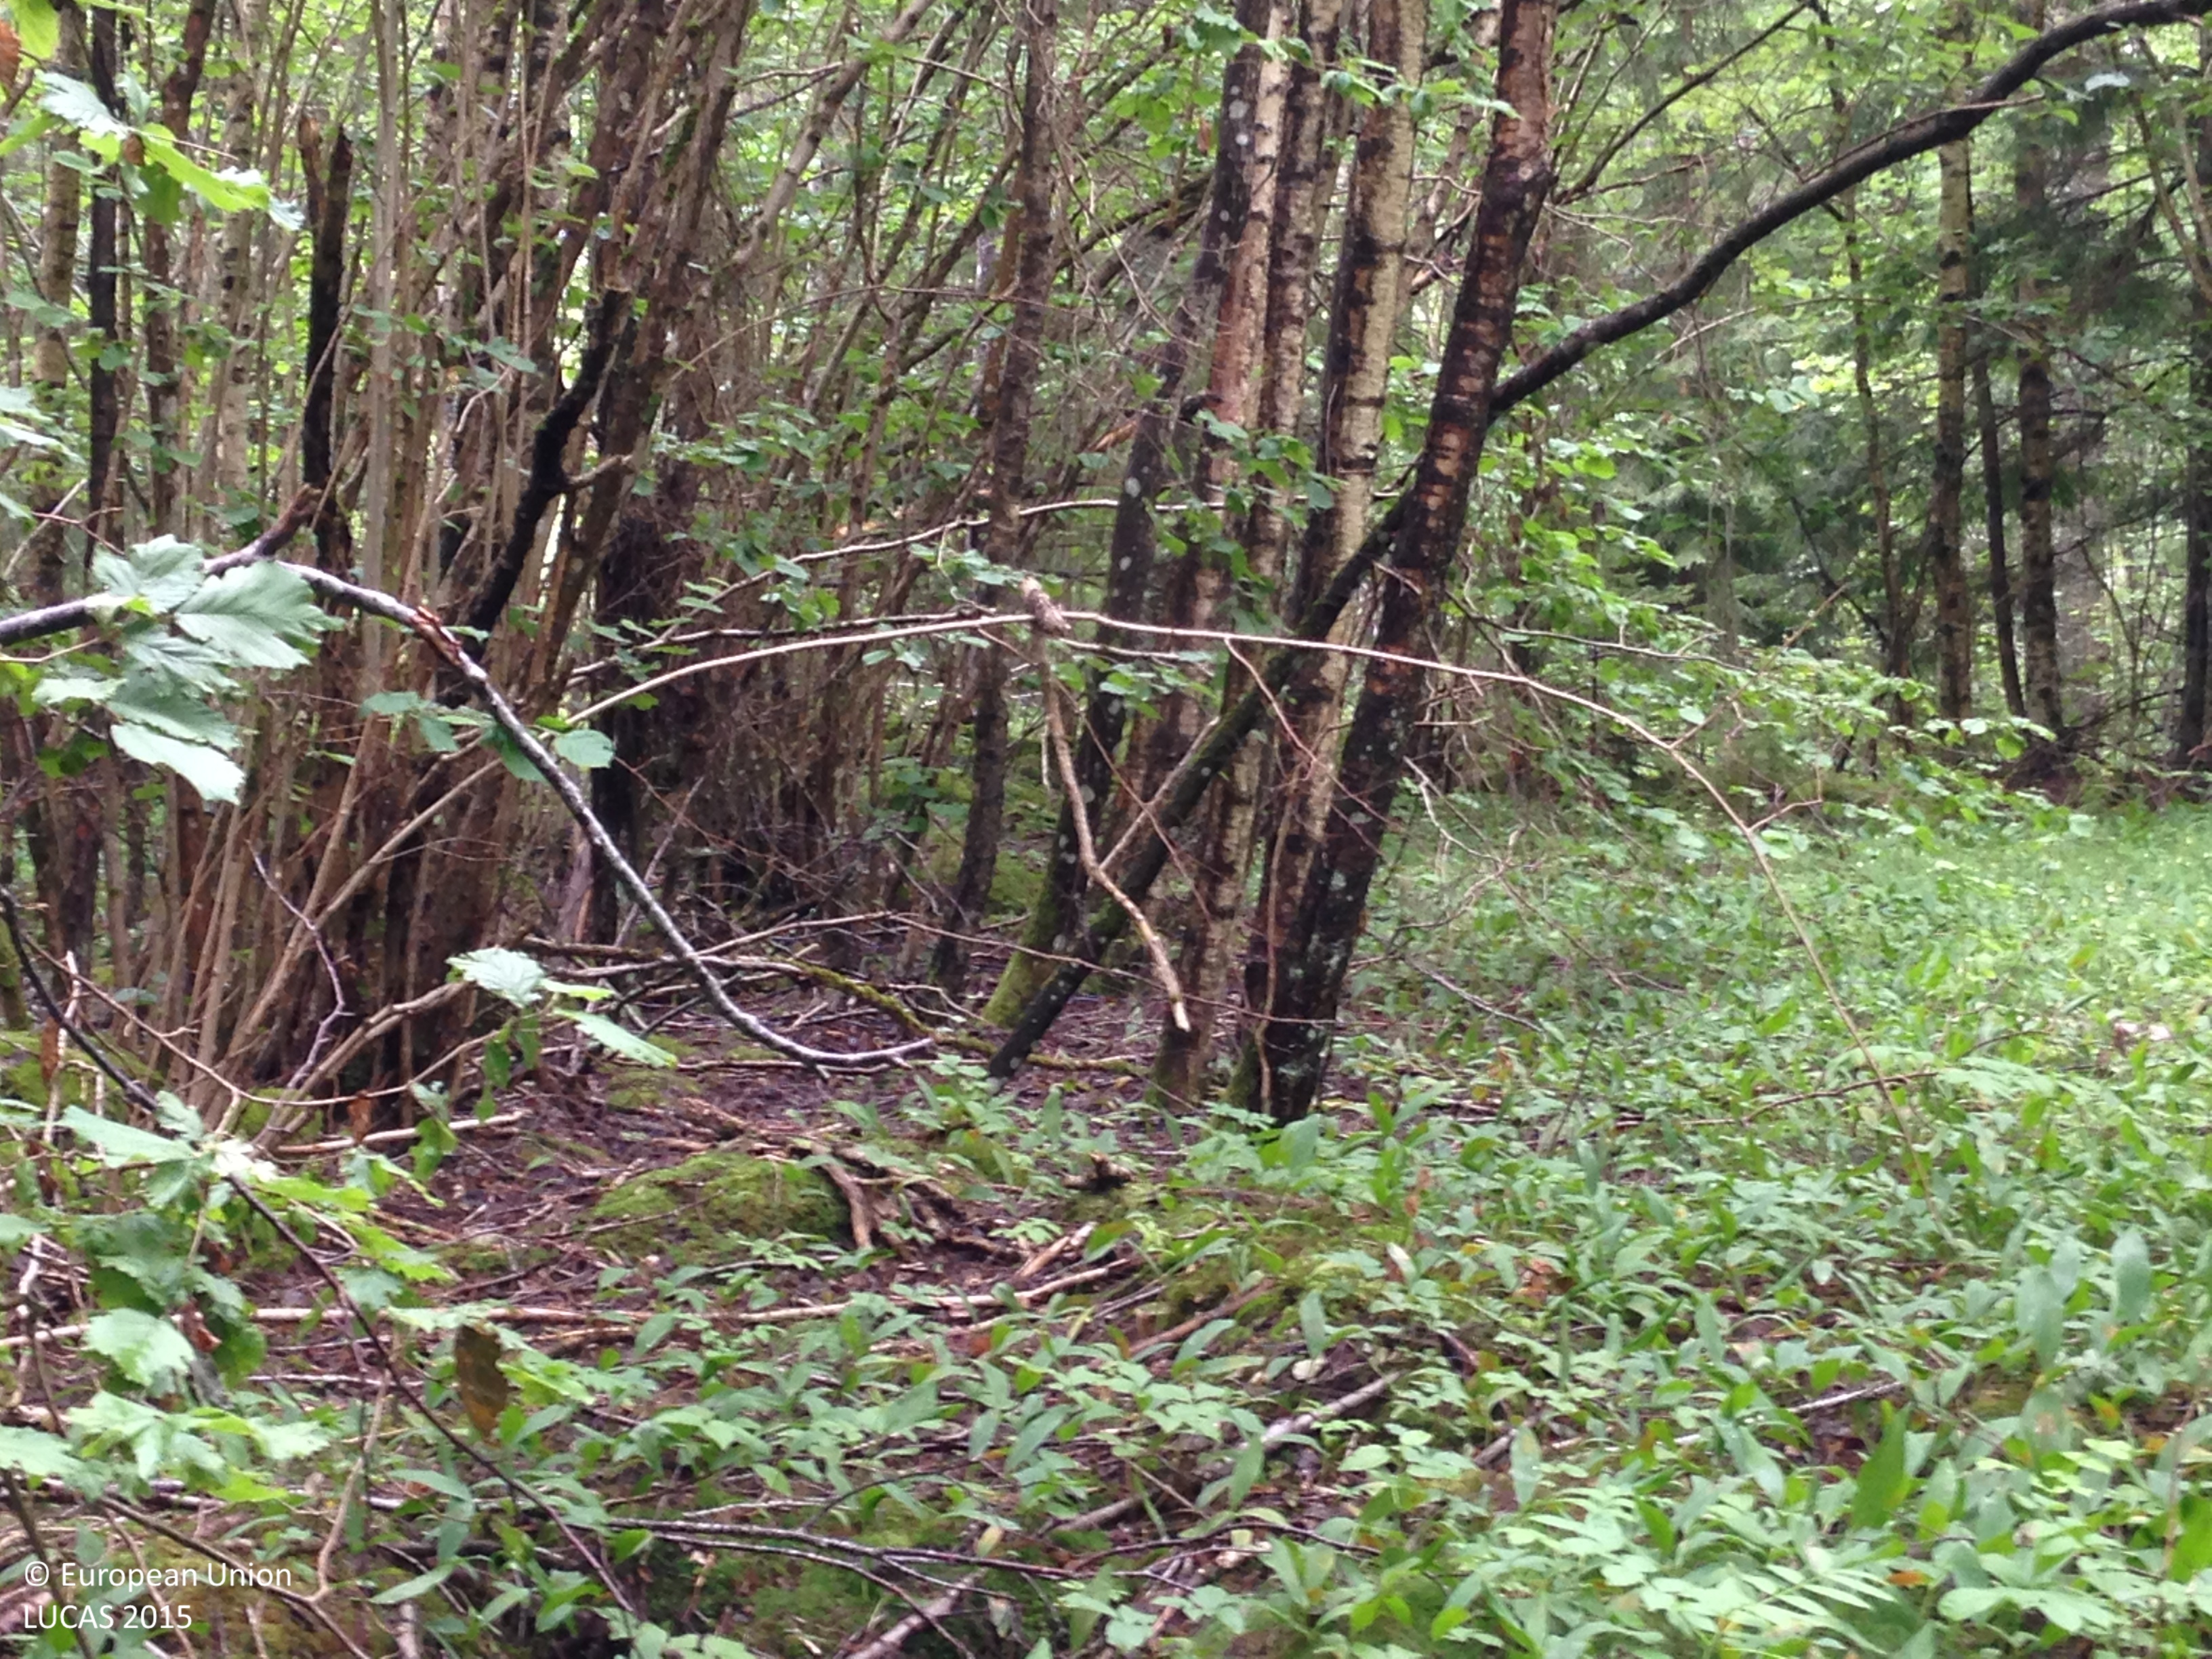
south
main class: Woodland
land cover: Spruce dominated mixed woodland
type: boreal forest
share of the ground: 50 - 75 %
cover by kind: coniferous forest trees 30 %, broadleaved forest trees 30 %, herbaceous plants 25 %, consolidated bare surface 10 %, shrubs 5 %
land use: Forestry
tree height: > 5 m
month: July
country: SE
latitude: 58.9239
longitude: 14.3521
